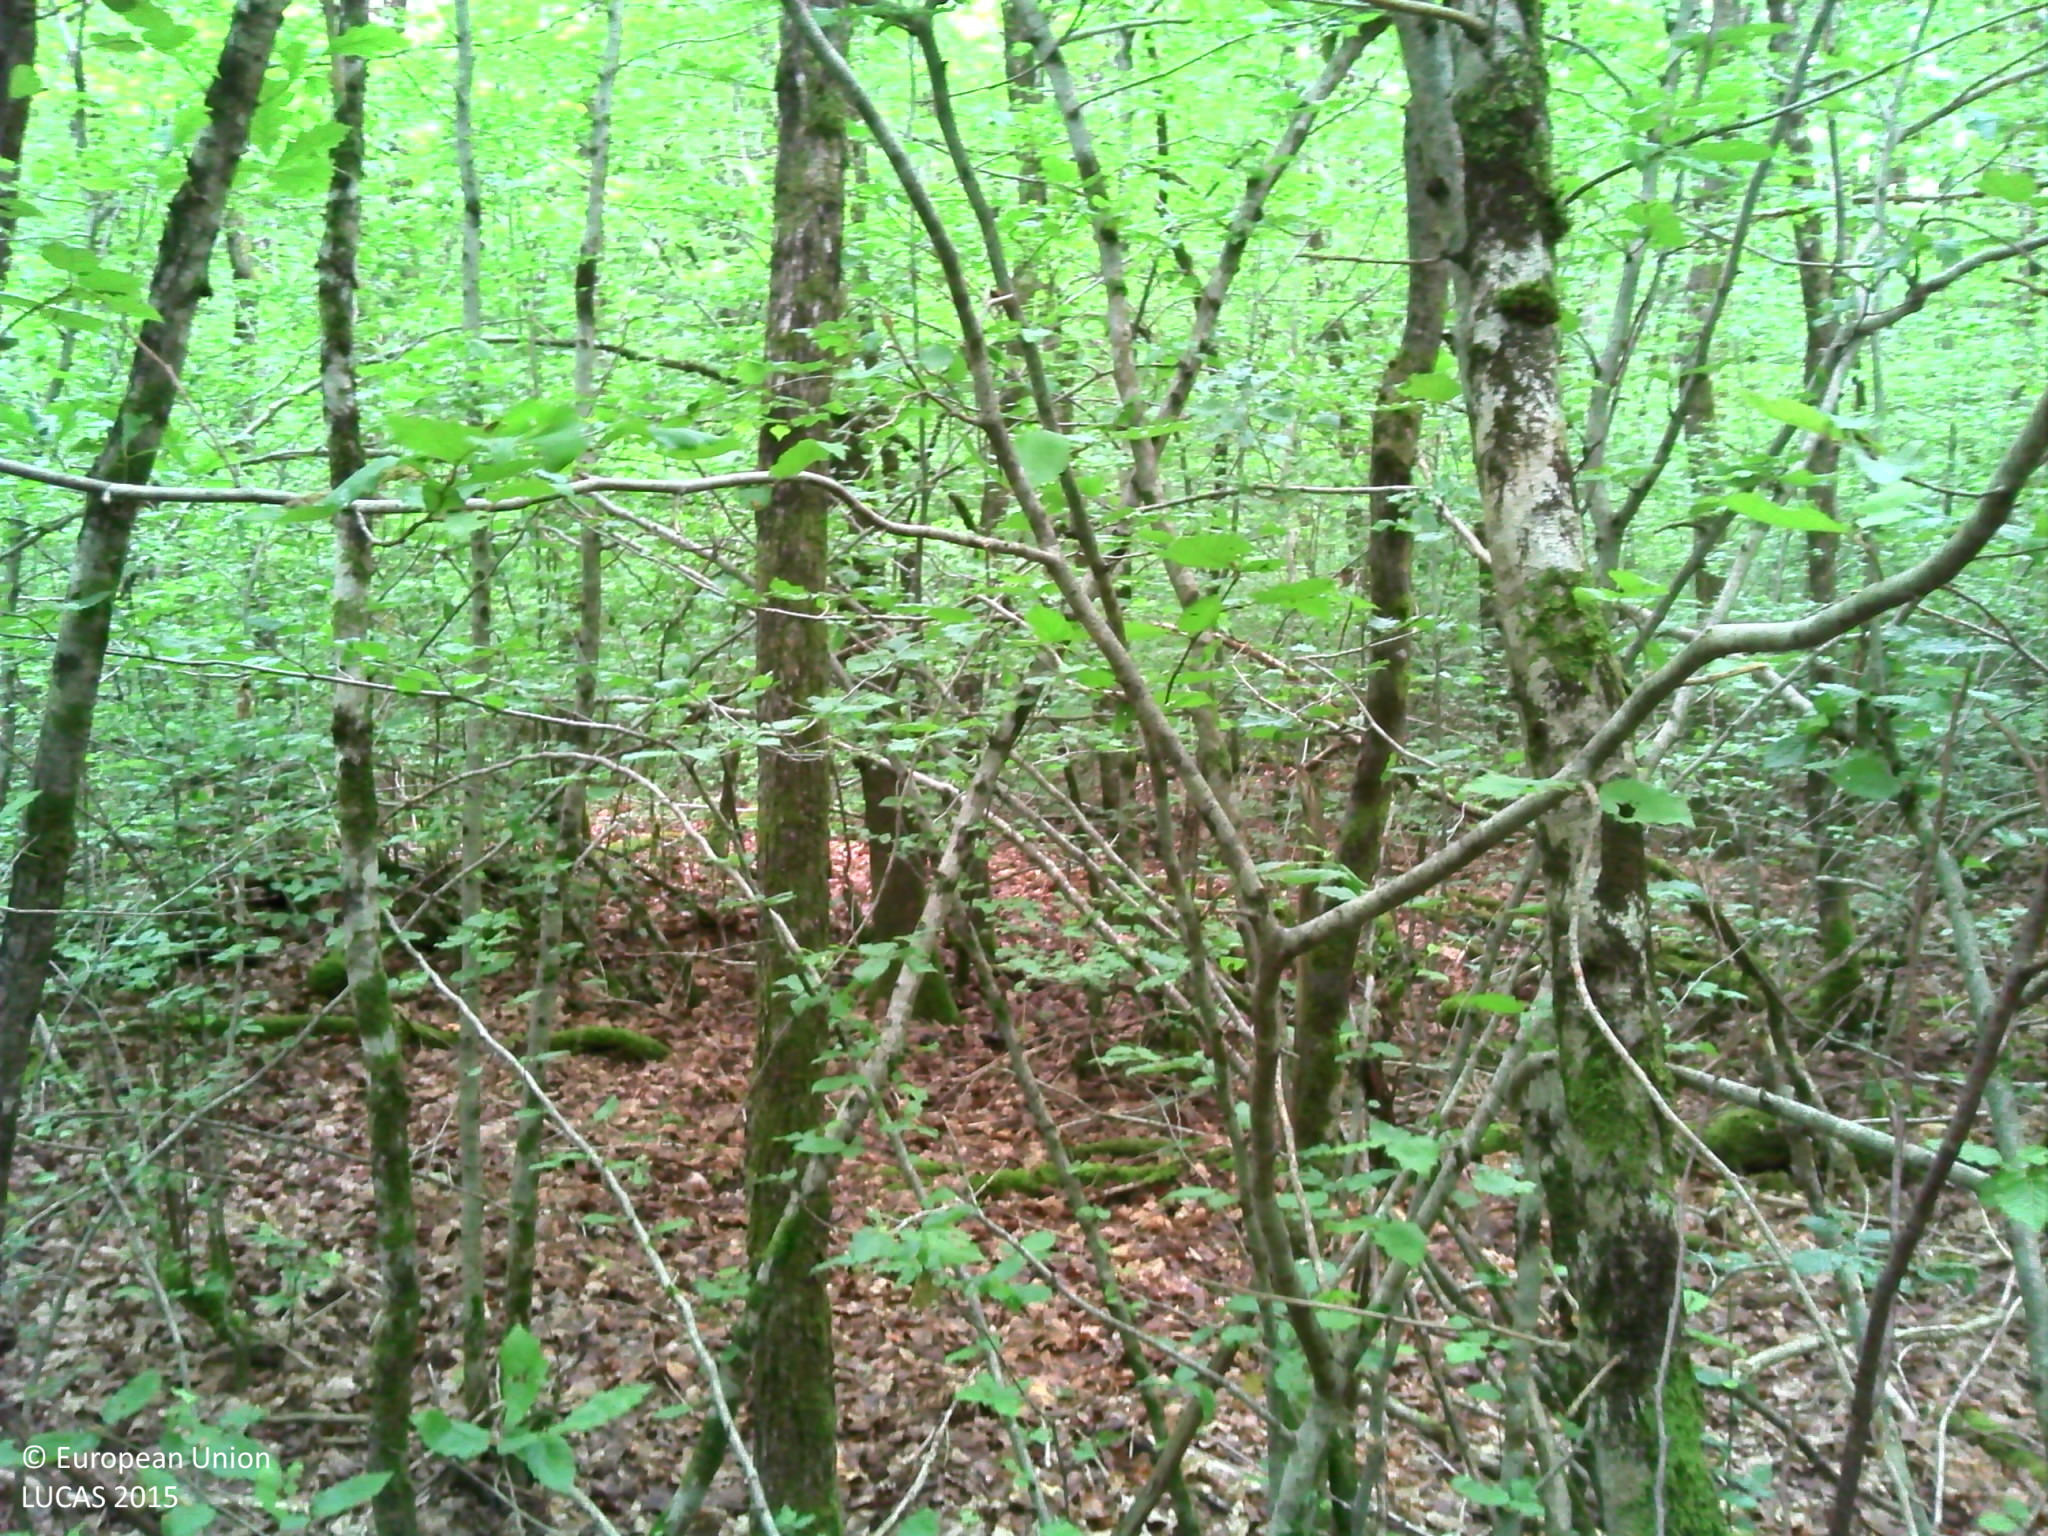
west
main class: Woodland
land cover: Broadleaved woodland
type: beech forest
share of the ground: > 75 %
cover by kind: broadleaved forest trees 95 %, herbaceous plants 5 %
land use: Forestry
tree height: > 5 m
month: May
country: FR
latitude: 47.9271
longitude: 6.2936
